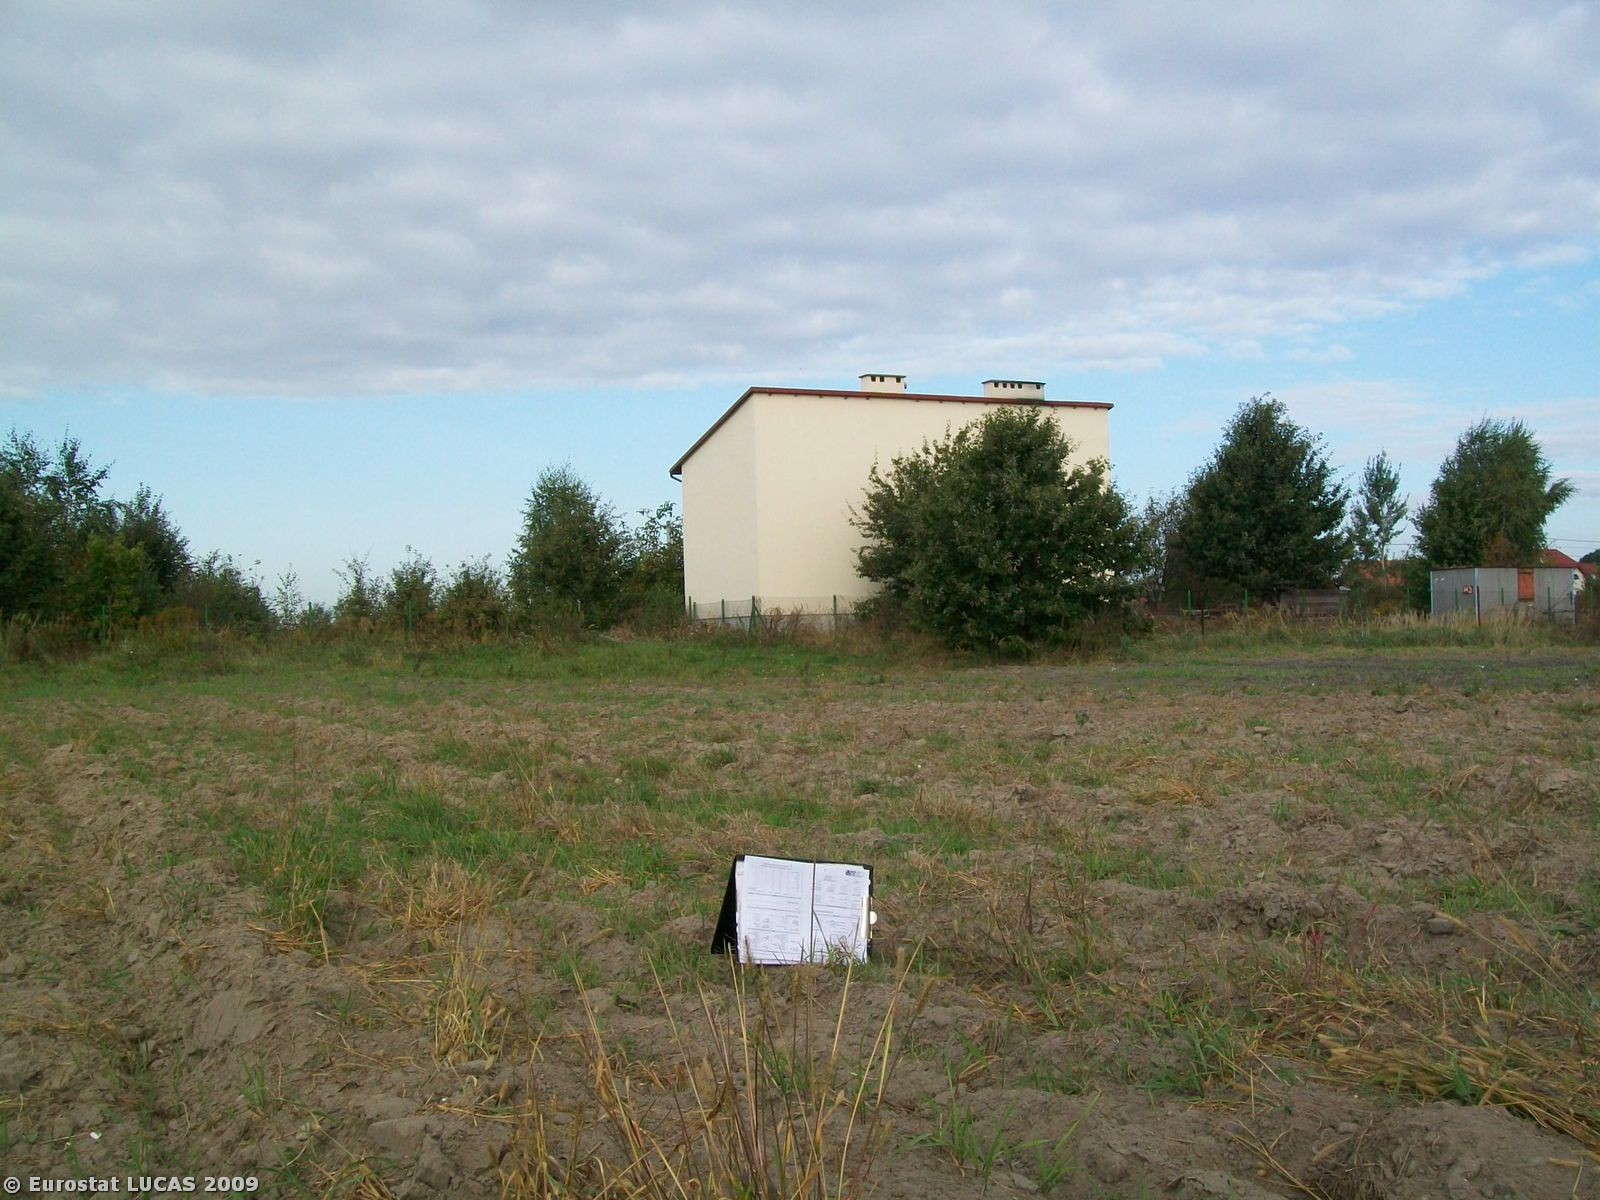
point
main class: Grassland
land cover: Grassland without tree/shrub cover
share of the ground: < 10 %
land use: Agriculture (excluding fallow land and kitchen gardens)
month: September
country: PL
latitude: 52.1895
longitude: 20.8228
